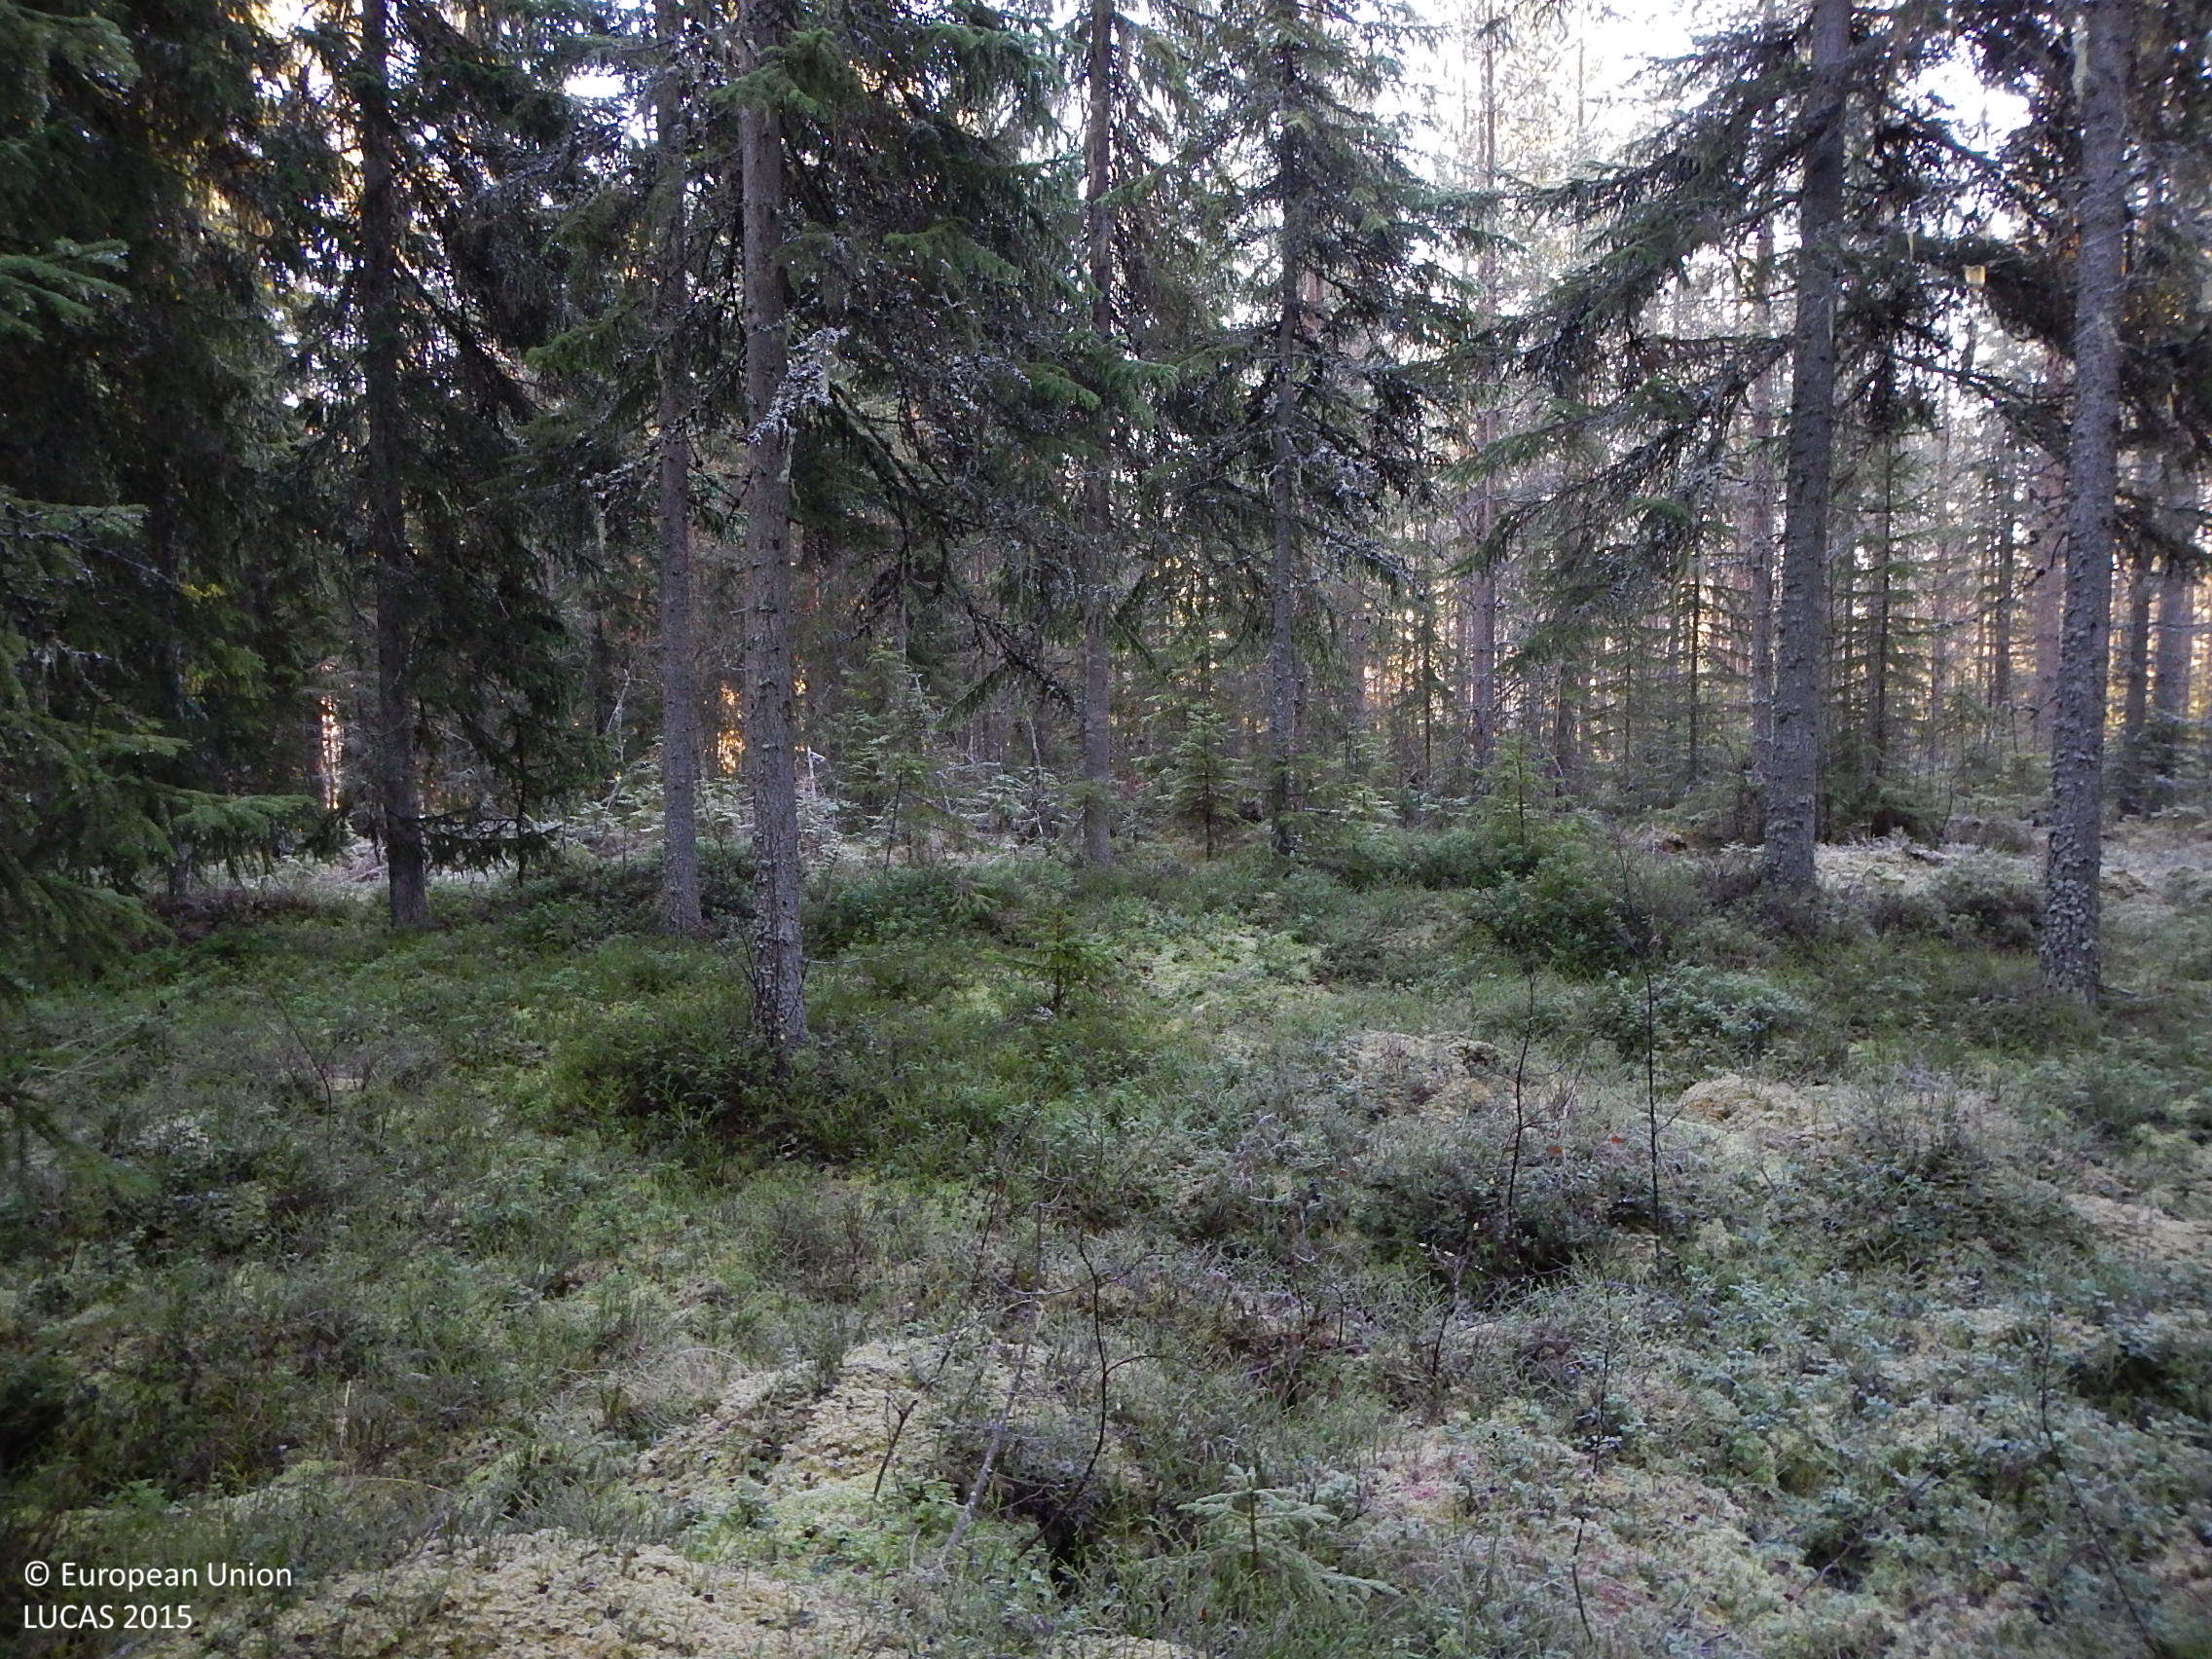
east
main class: Woodland
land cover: Spruce dominated coniferous woodland
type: boreal forest
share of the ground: 50 - 75 %
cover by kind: coniferous forest trees 50 %, shrubs 30 %, lichens and mosses 20 %
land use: Forestry
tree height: > 5 m
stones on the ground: < 10 %
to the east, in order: Spruce dominated coniferous woodland; Spruce dominated mixed woodland; Spontaneously vegetated surfaces; Paved roads, cycling and walking lanes; Spontaneously vegetated surfaces; Electric lines; Spruce dominated mixed woodland; Inland fresh running water; Spruce dominated mixed woodland; Spruce dominated coniferous woodland; Ditches and canals; Spruce dominated coniferous woodland
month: November
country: SE
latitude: 61.5920
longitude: 15.9188
